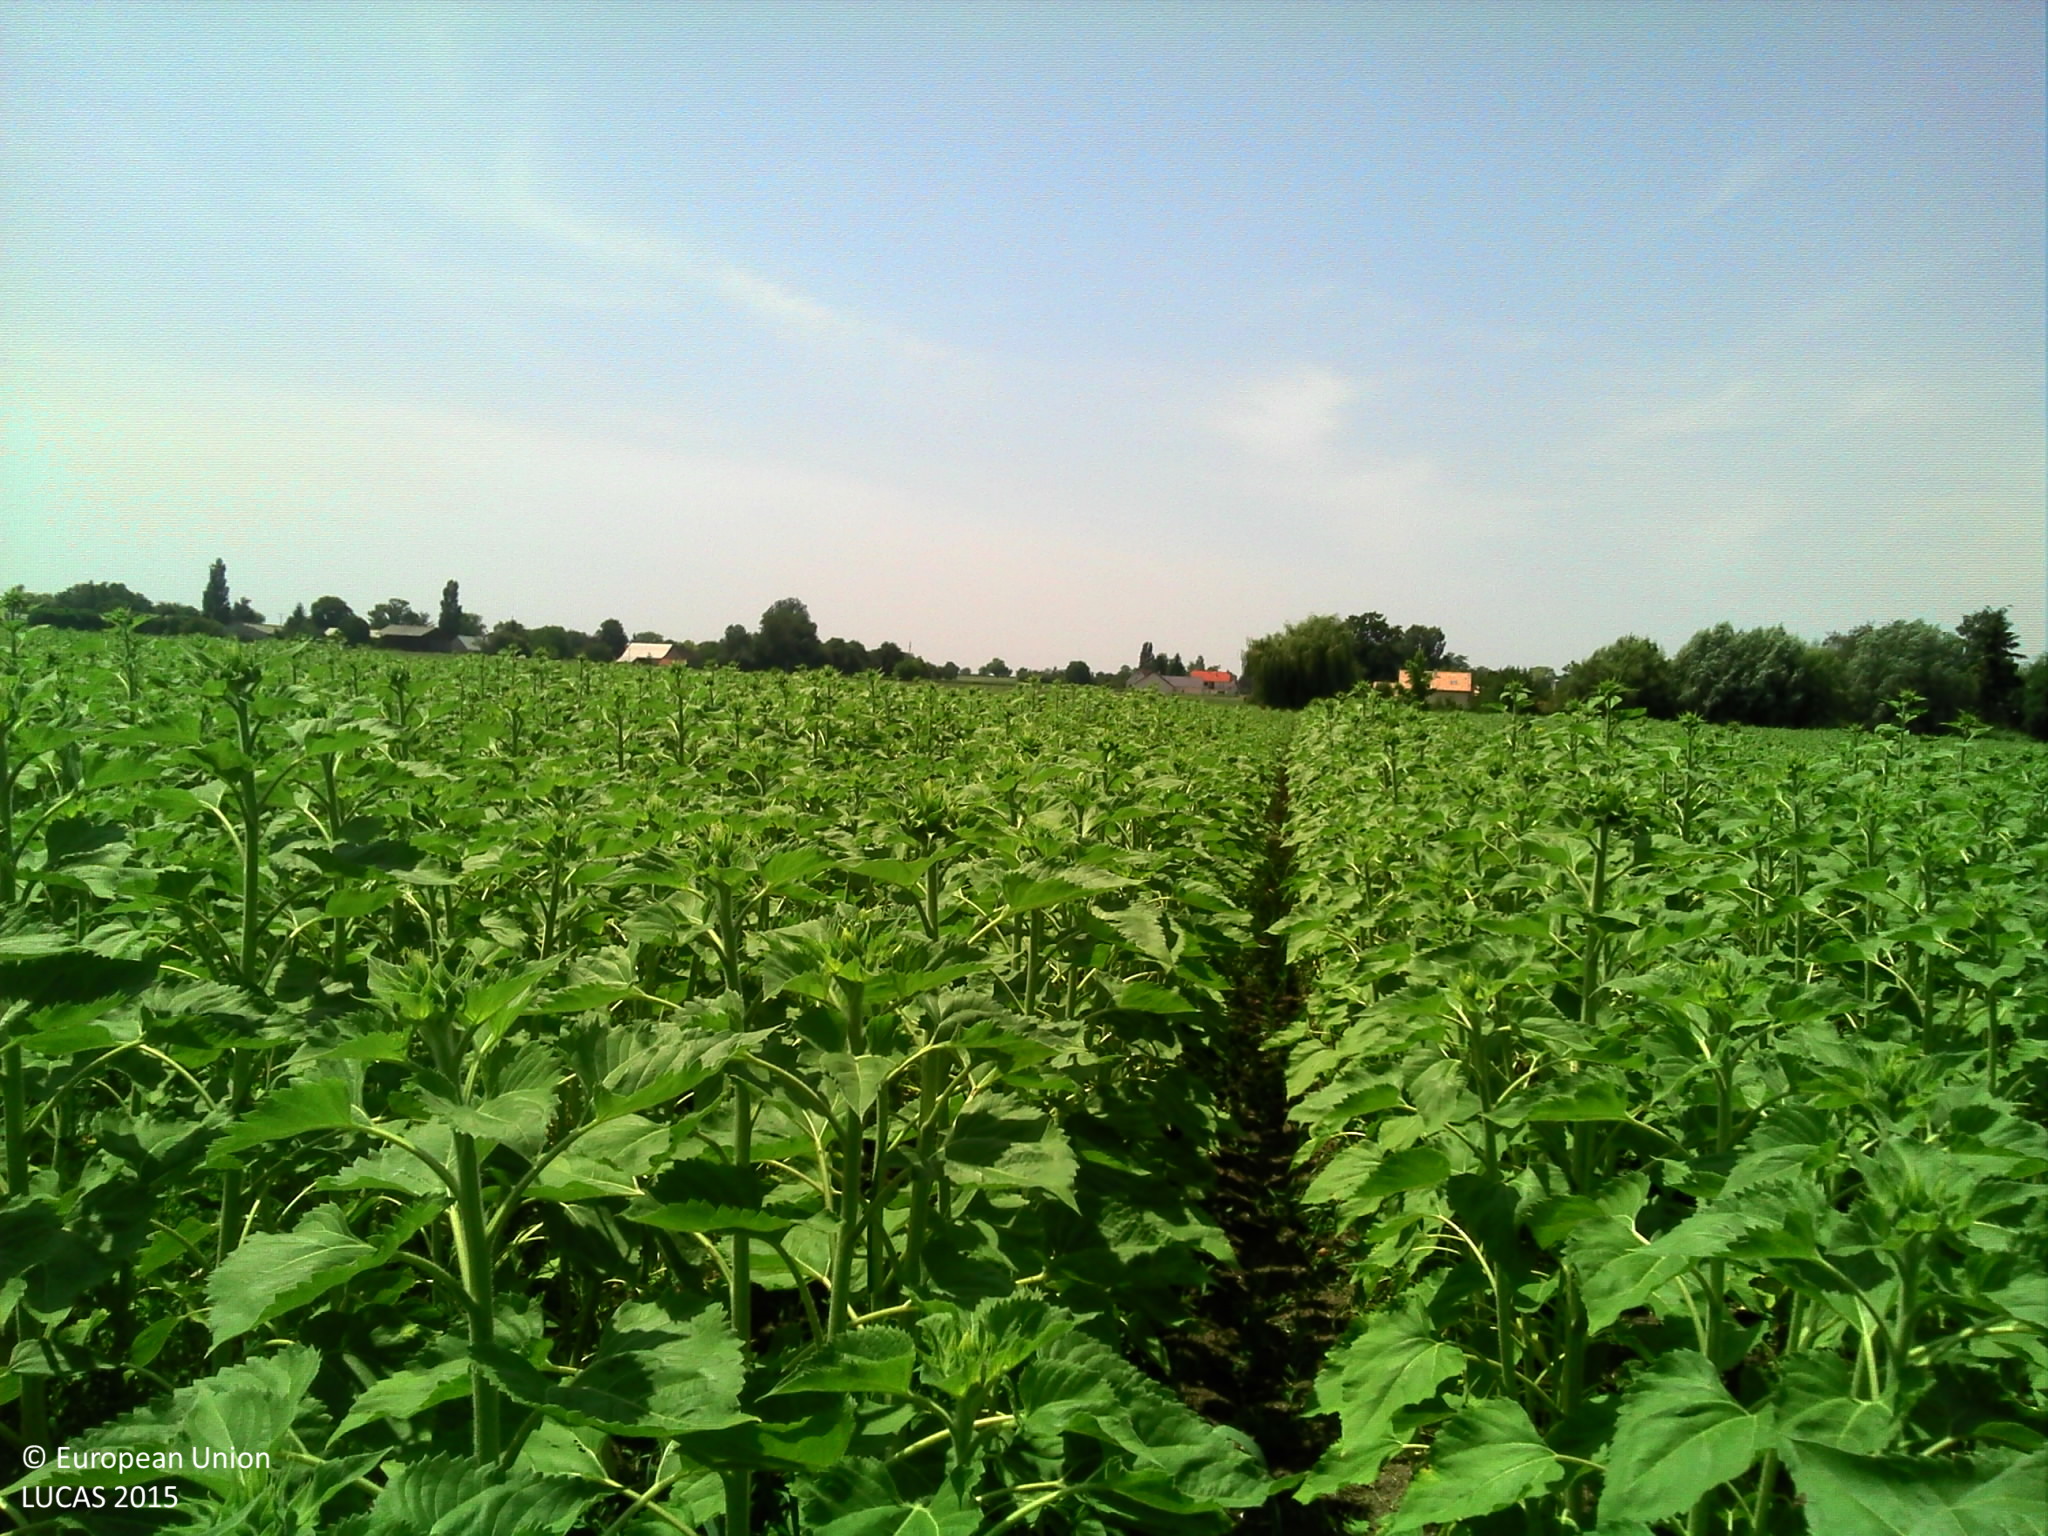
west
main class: Cropland
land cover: Sunflower
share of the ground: > 75 %
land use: Agriculture (excluding fallow land and kitchen gardens)
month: July
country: FR
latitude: 46.1040
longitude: 3.2852
